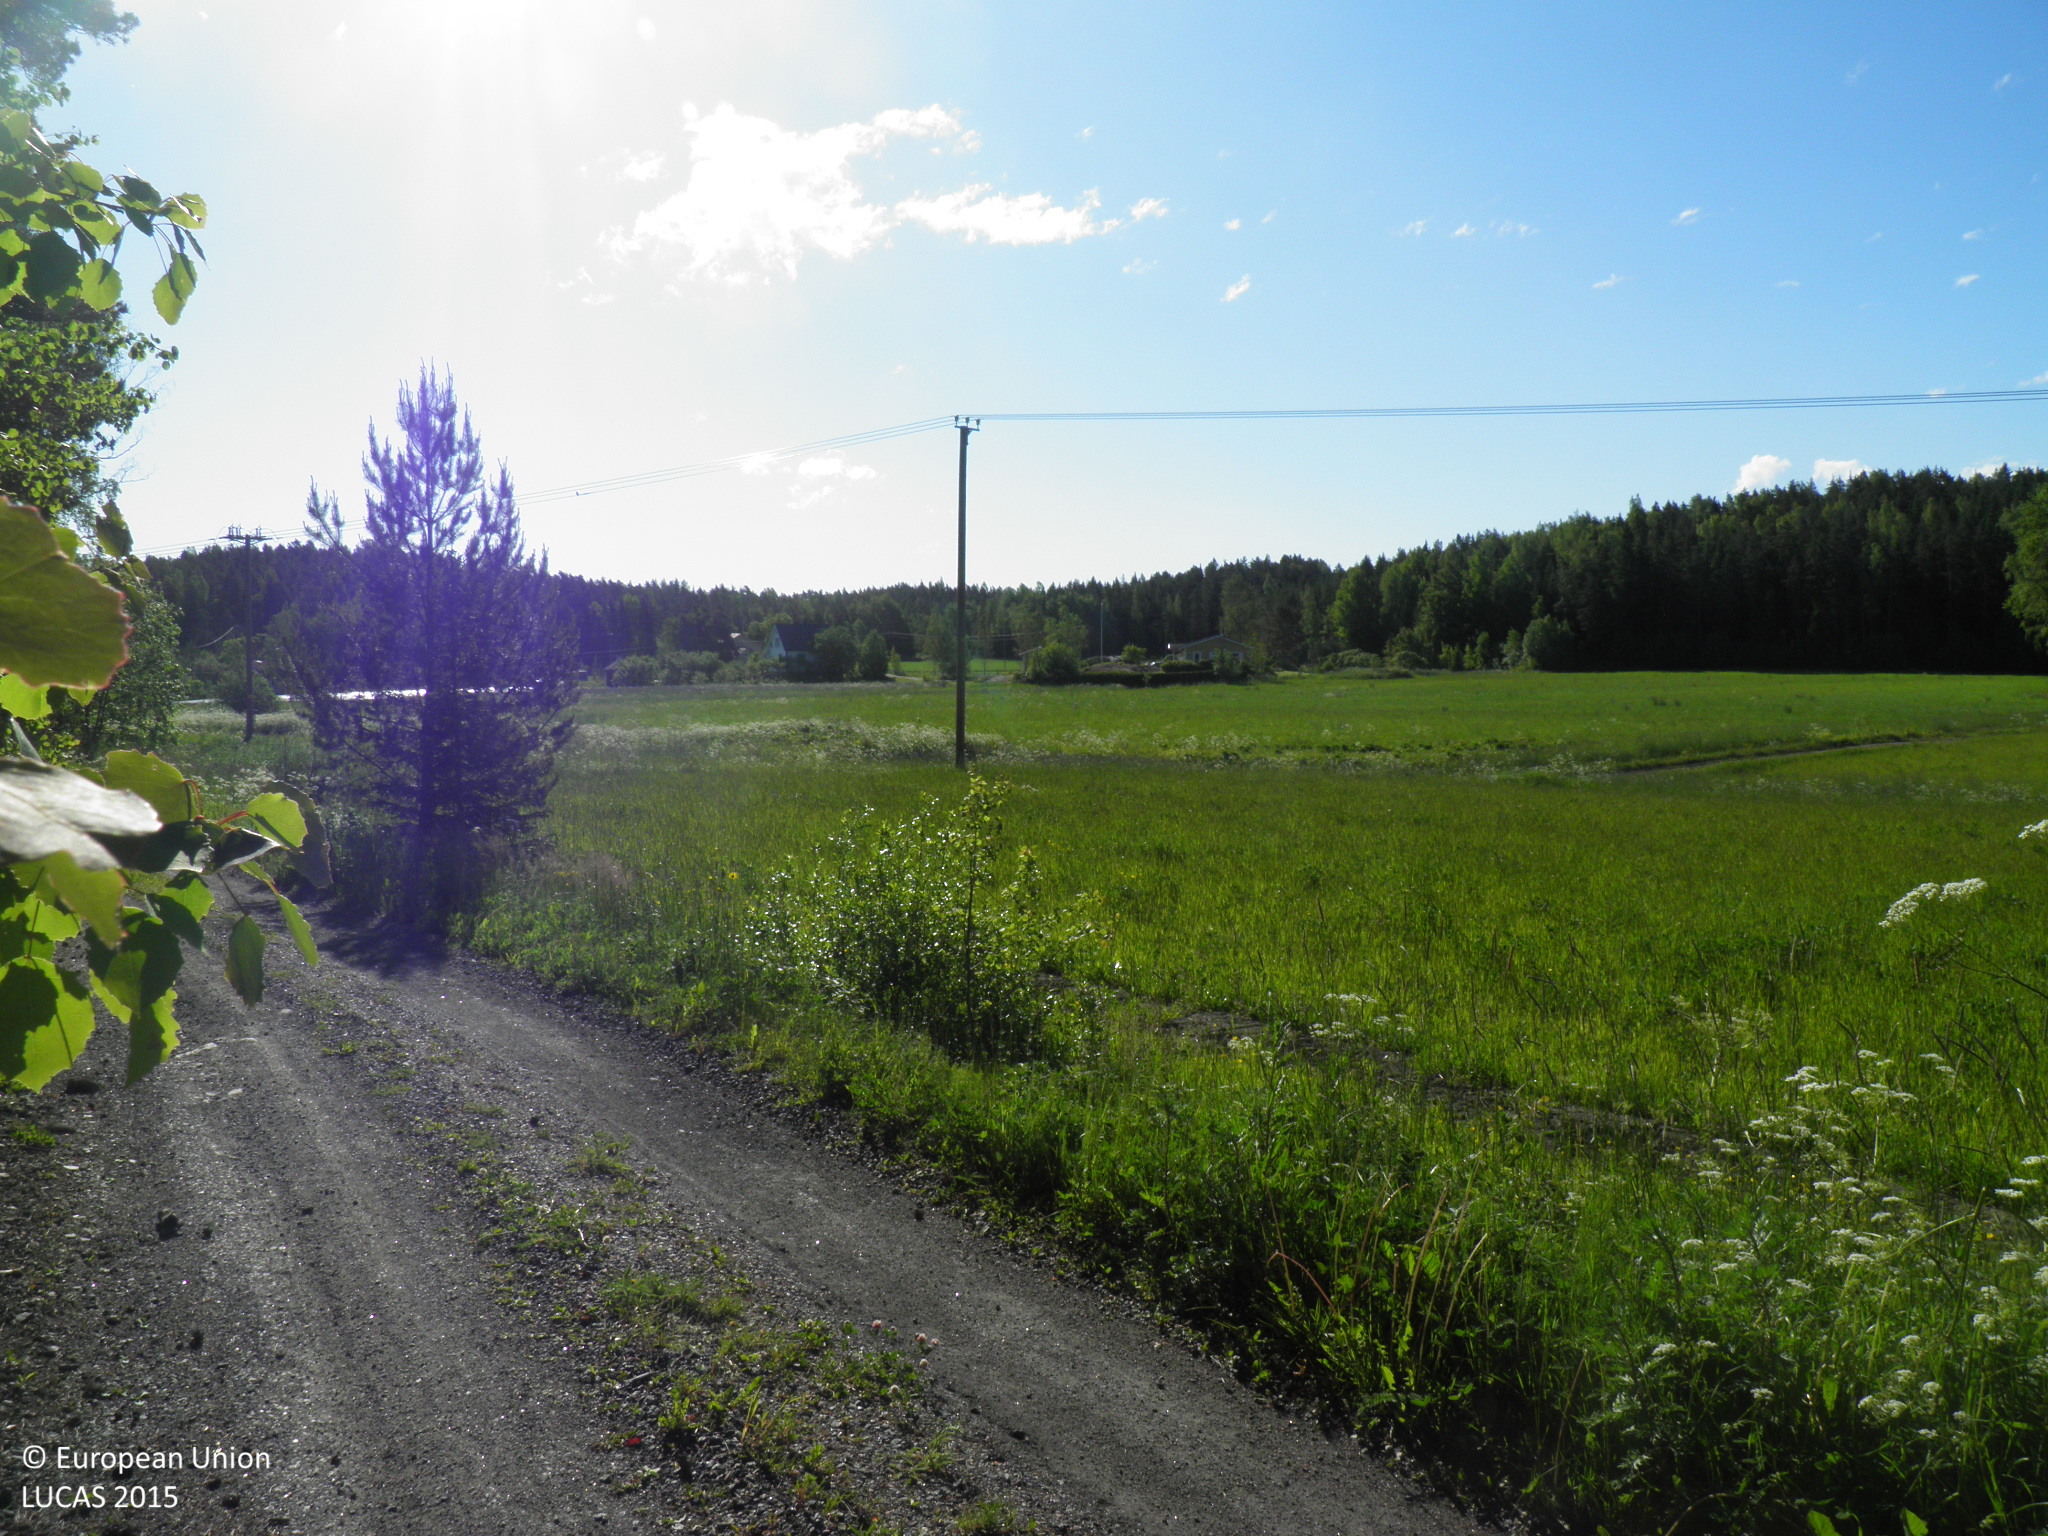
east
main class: Woodland
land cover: Pine dominated coniferous woodland
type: boreal forest
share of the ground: > 75 %
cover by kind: coniferous forest trees 70 %, broadleaved forest trees 10 %, shrubs 10 %, herbaceous plants 10 %
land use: Forestry
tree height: > 5 m
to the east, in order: Pine dominated coniferous woodland; Paved roads, cycling and walking lanes; Grass margins; Grassland without tree/shrub cover; Tracks; Grass margins; Ditches and canals; Grassland without tree/shrub cover; Electric lines; Grassland without tree/shrub cover; Ditches and canals; Shrubland without tree cover
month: June
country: FI
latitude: 60.4035
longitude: 22.5416
